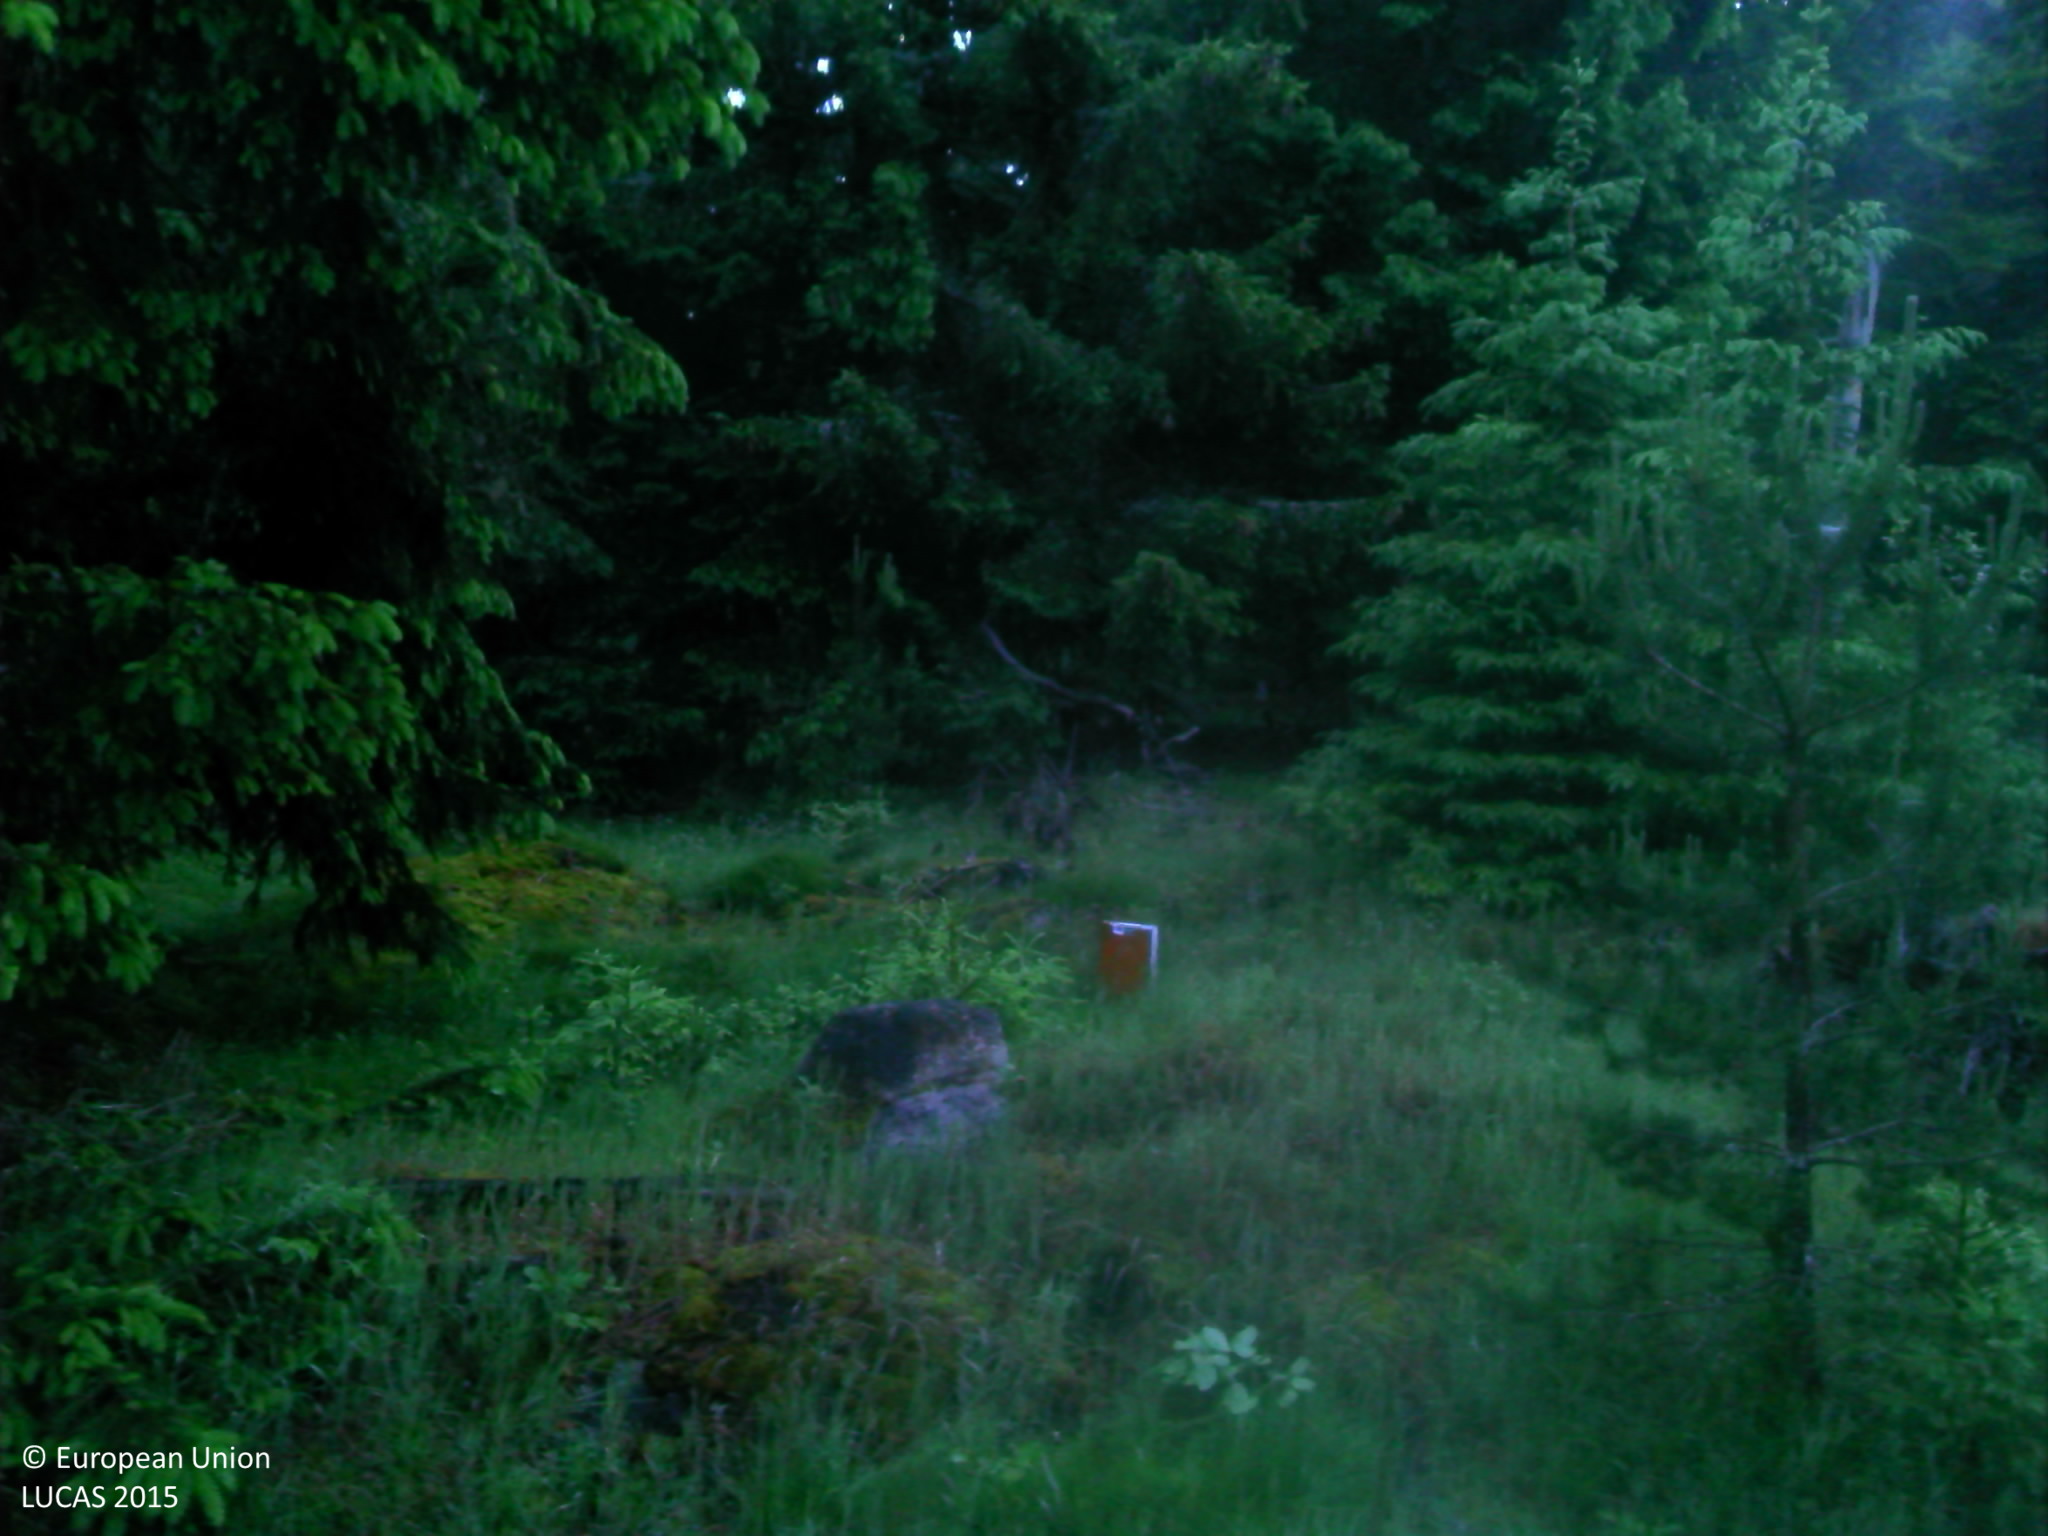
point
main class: Woodland
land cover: Spruce dominated coniferous woodland
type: alpine coniferous forest
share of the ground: > 75 %
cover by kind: coniferous forest trees 50 %, herbaceous plants 40 %, shrubs 5 %, lichens and mosses 5 %
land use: Forestry
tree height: > 5 m
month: June
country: FR
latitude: 45.1919
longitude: 2.8859
